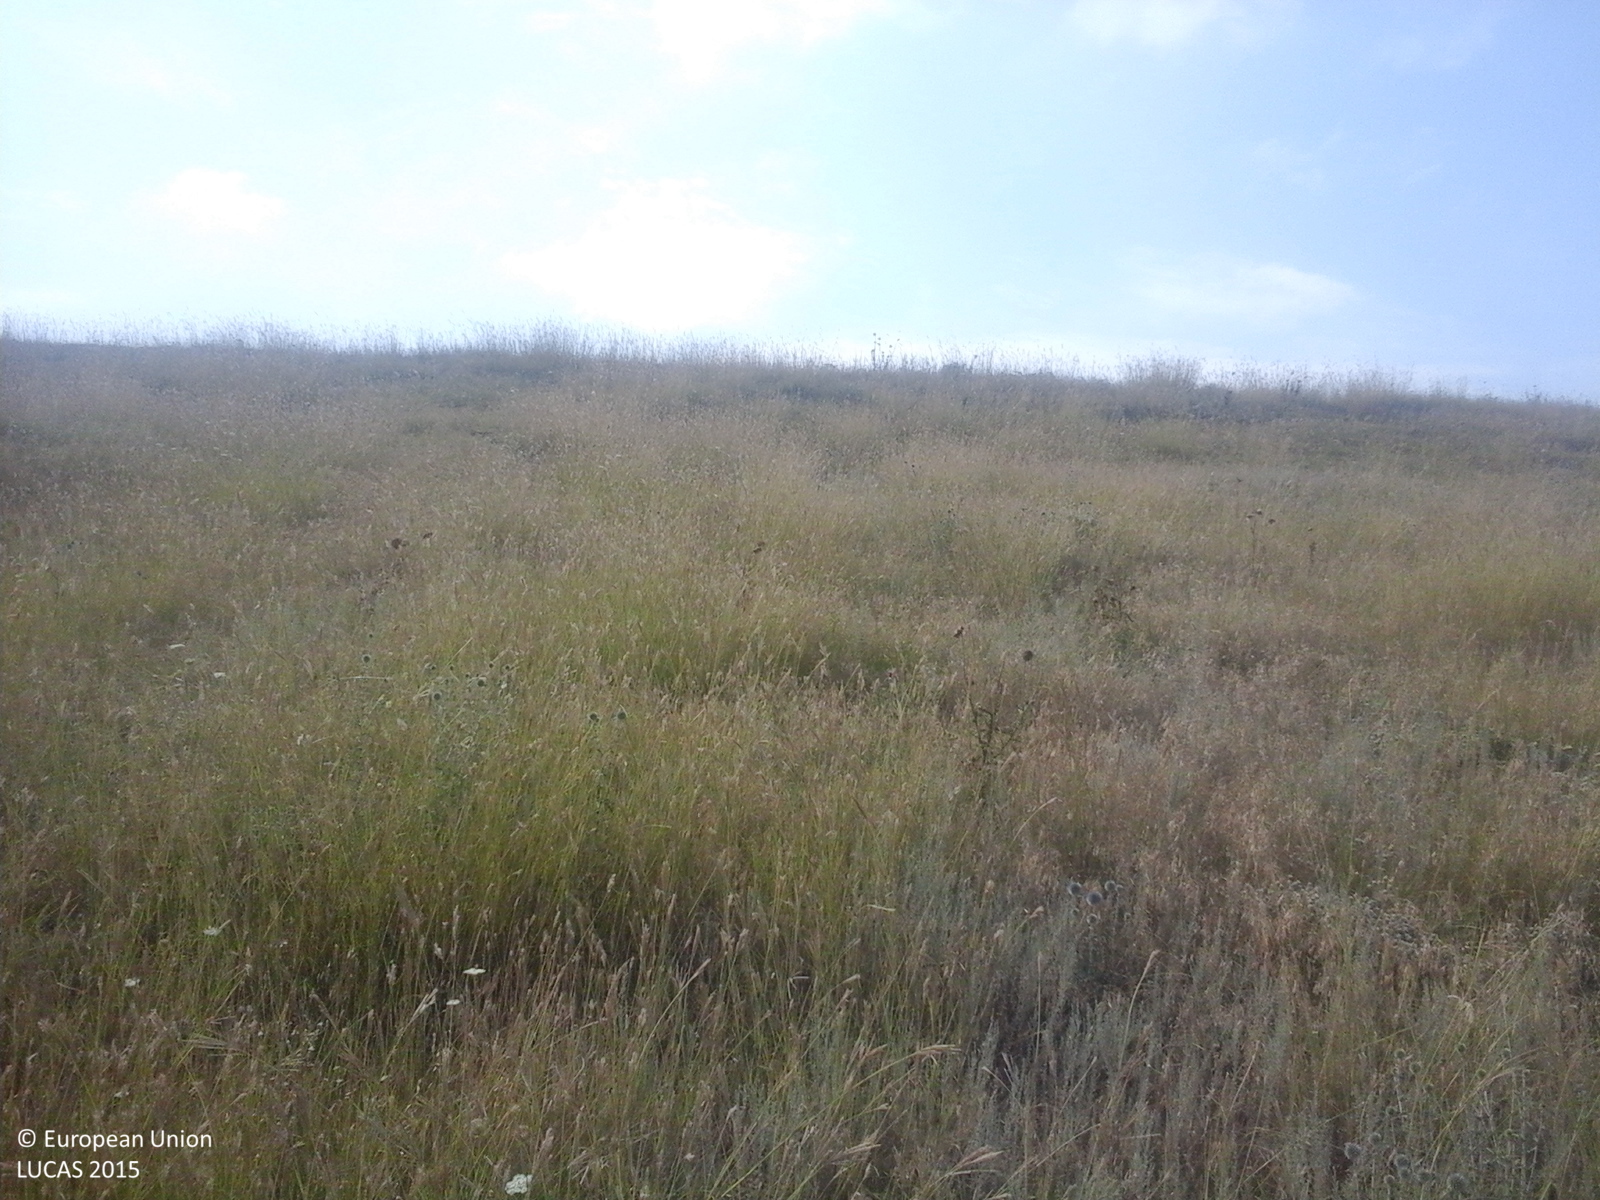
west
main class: Grassland
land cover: Grassland without tree/shrub cover
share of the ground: > 75 %
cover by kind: herbaceous plants 100 %
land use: Agriculture (excluding fallow land and kitchen gardens)
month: July
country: RO
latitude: 45.2735
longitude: 28.2887
